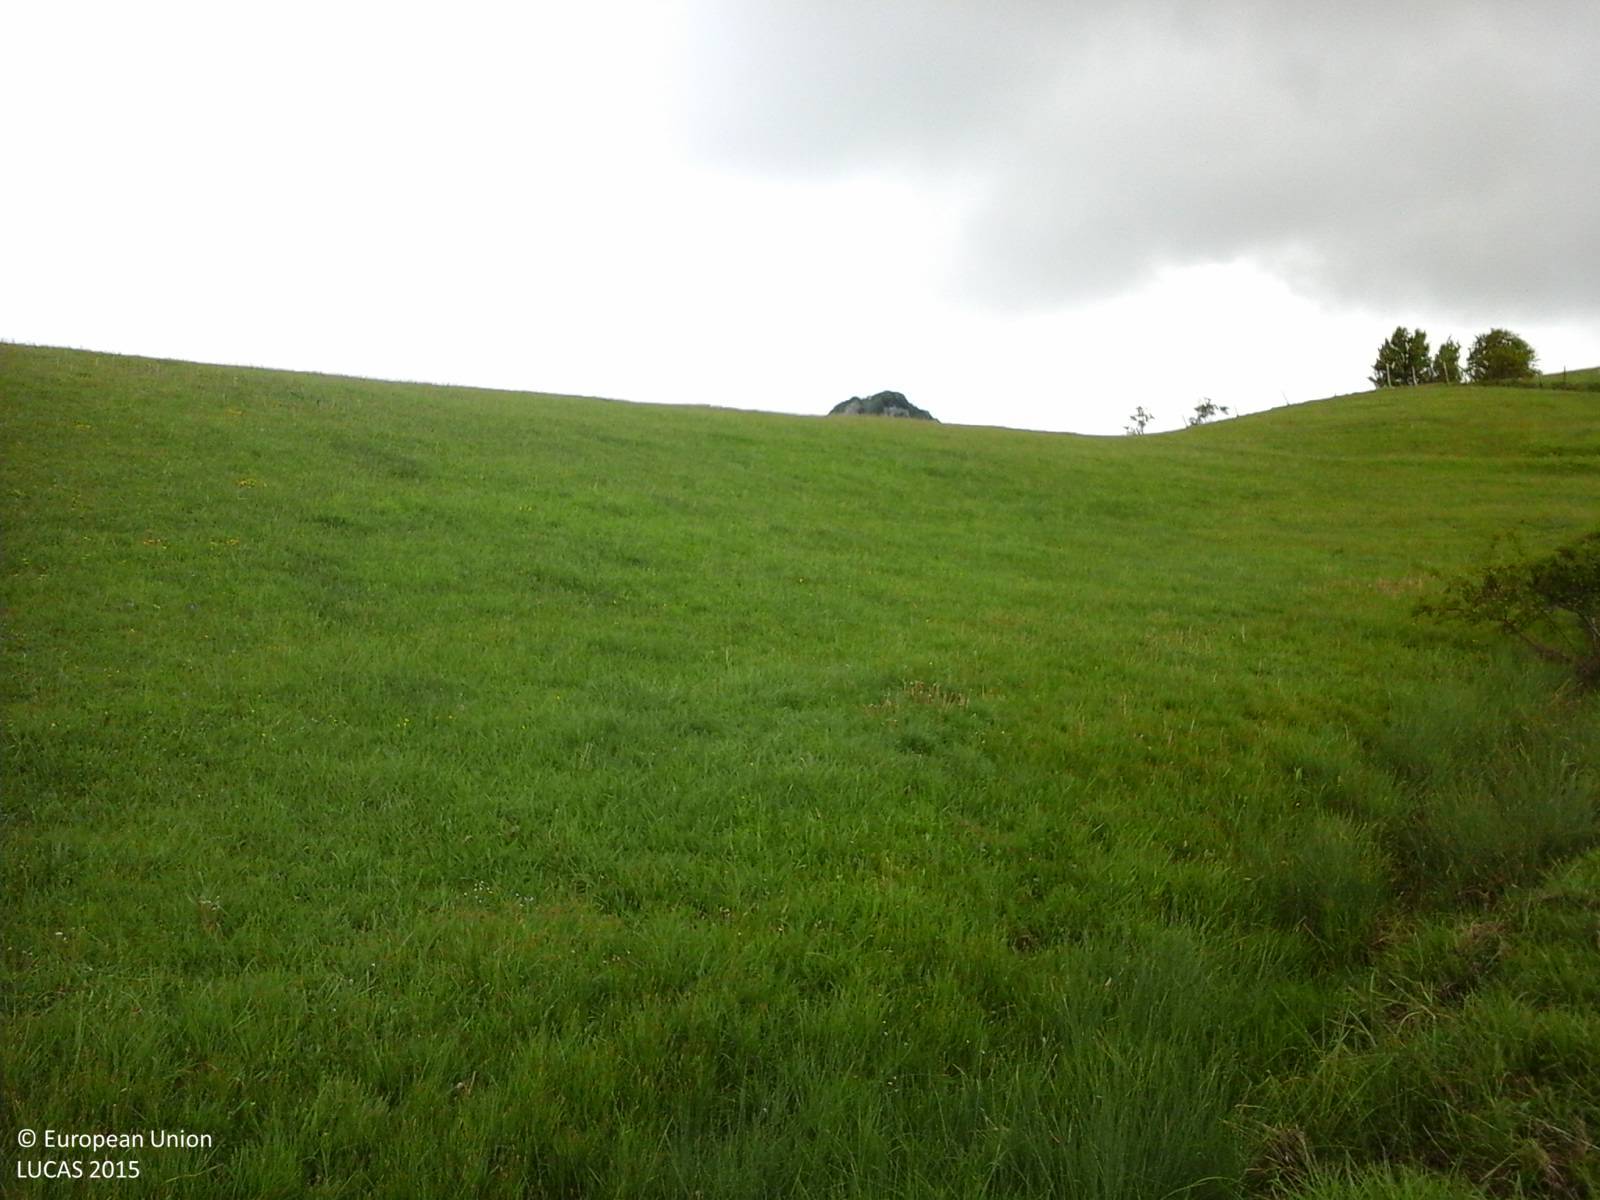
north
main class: Grassland
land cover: Grassland without tree/shrub cover
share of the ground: > 75 %
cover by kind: herbaceous plants 100 %
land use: Agriculture (excluding fallow land and kitchen gardens)
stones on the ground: < 10 %
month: May
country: IT
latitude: 41.8980
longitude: 14.1926
